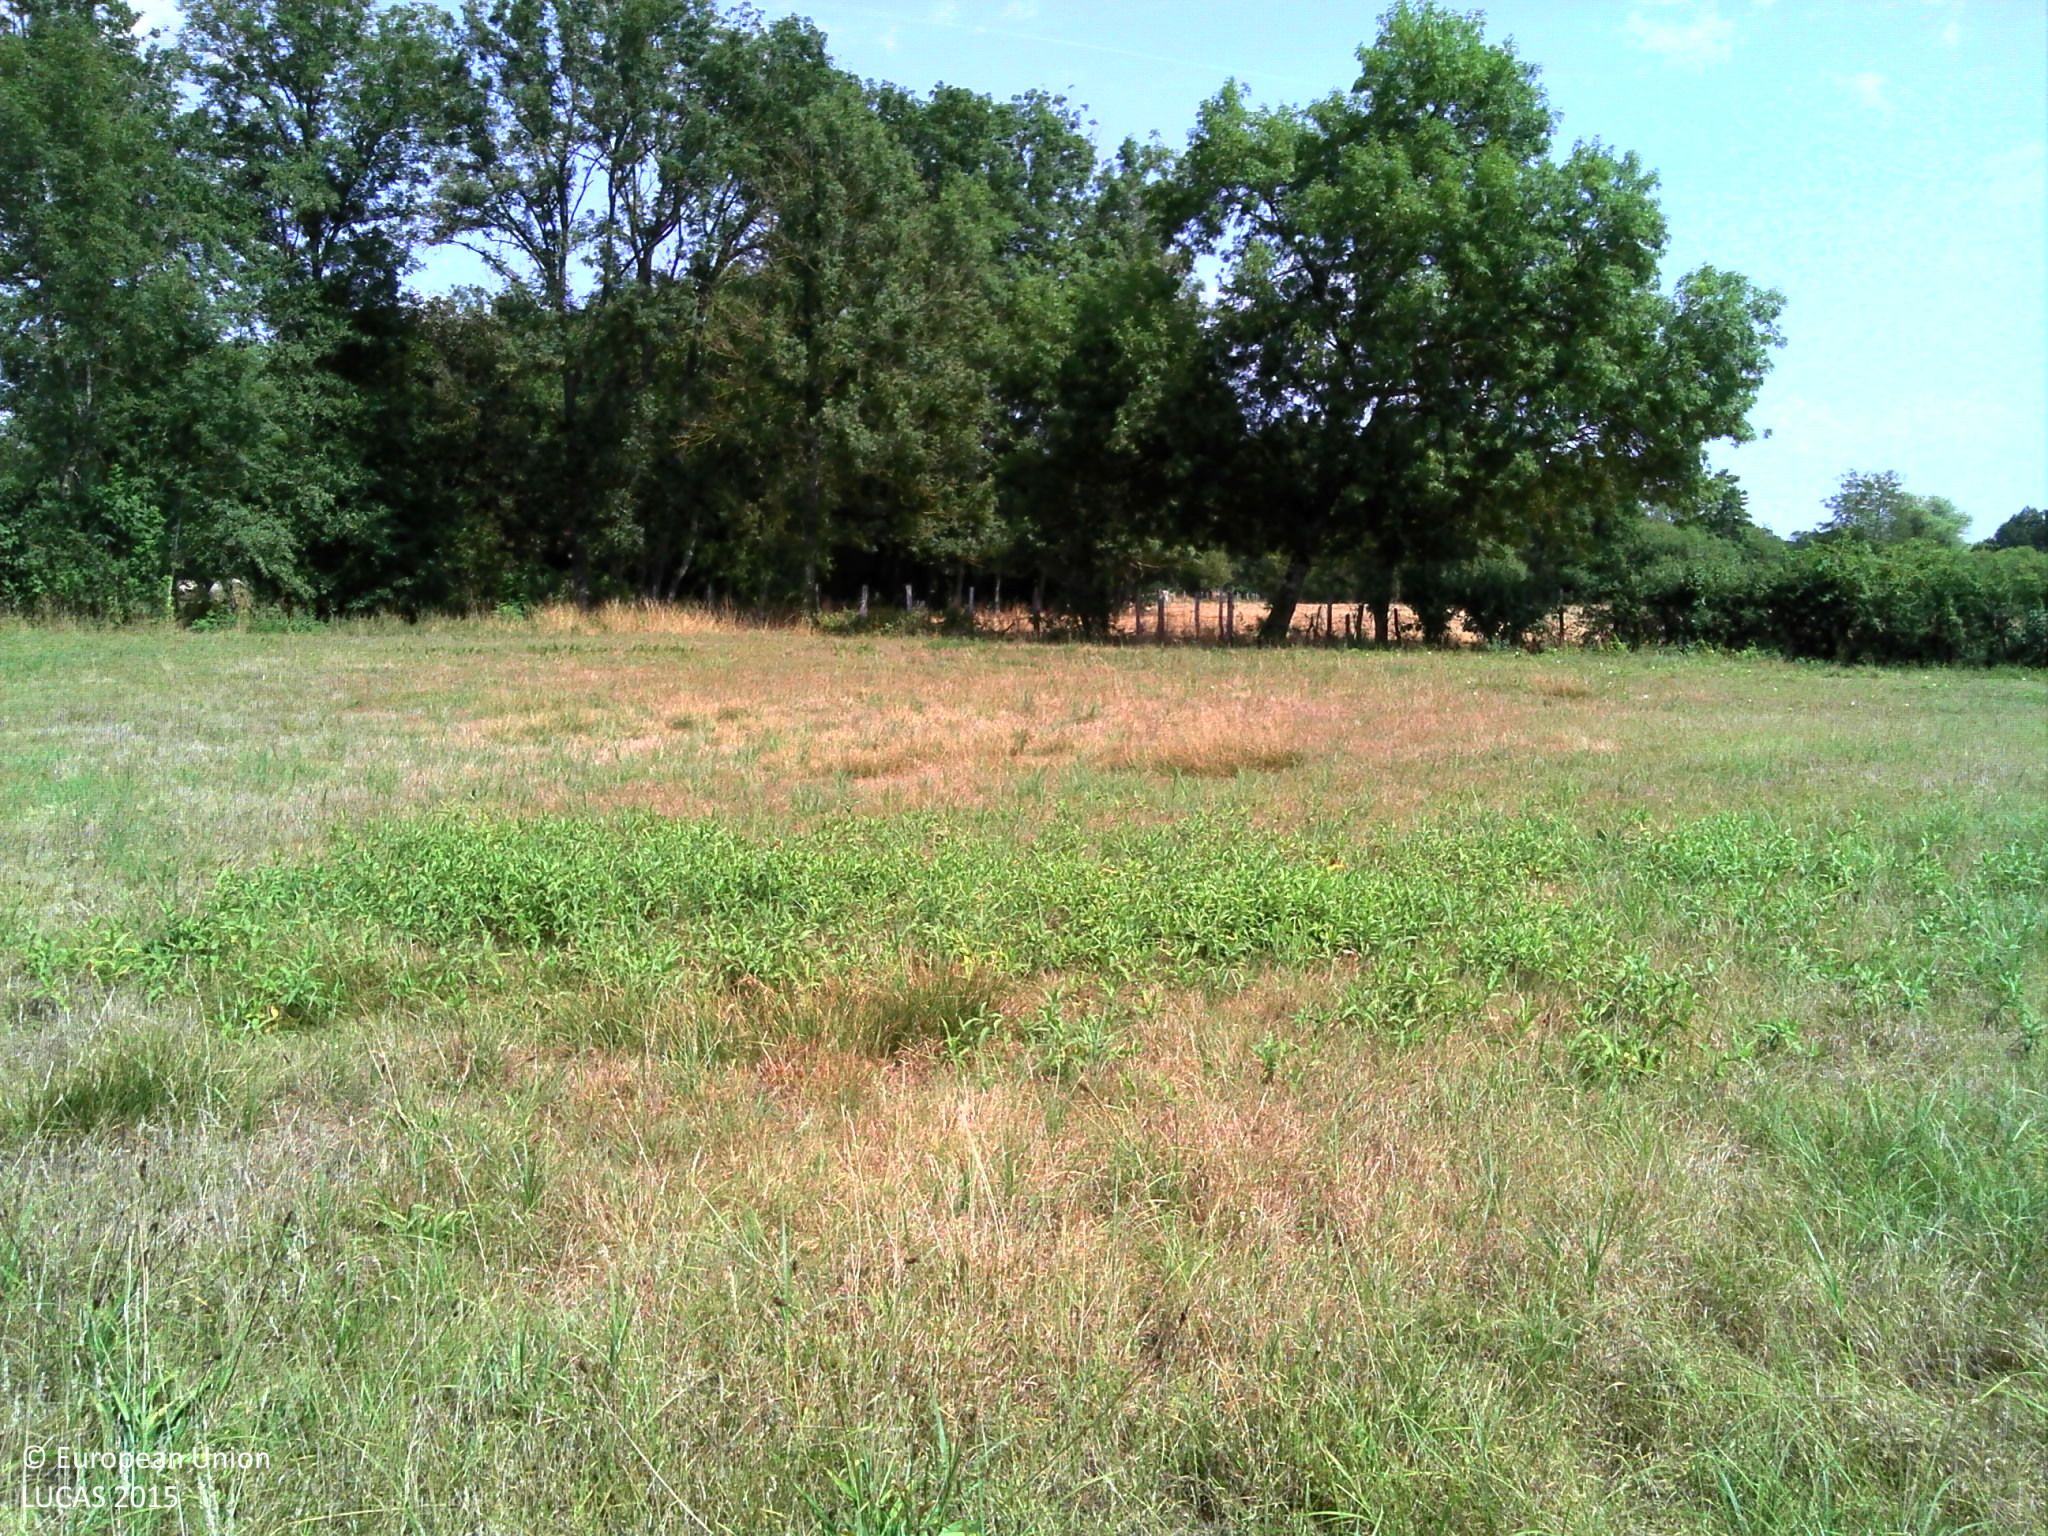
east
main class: Grassland
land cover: Grassland without tree/shrub cover
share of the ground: > 75 %
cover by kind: herbaceous plants 100 %
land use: Agriculture (excluding fallow land and kitchen gardens)
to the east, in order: Grassland without tree/shrub cover; Fences; Lines of trees; Grassland without tree/shrub cover; Fences; Lines of trees; Inland fresh running water; Lines of trees; Fences; Grassland without tree/shrub cover; Ditches and canals; Fences; Grassland with sparse tree/shrub cover; Fences; Managed hedges; Grassland with sparse tree/shrub cover
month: August
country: FR
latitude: 47.8113
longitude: 3.1434
